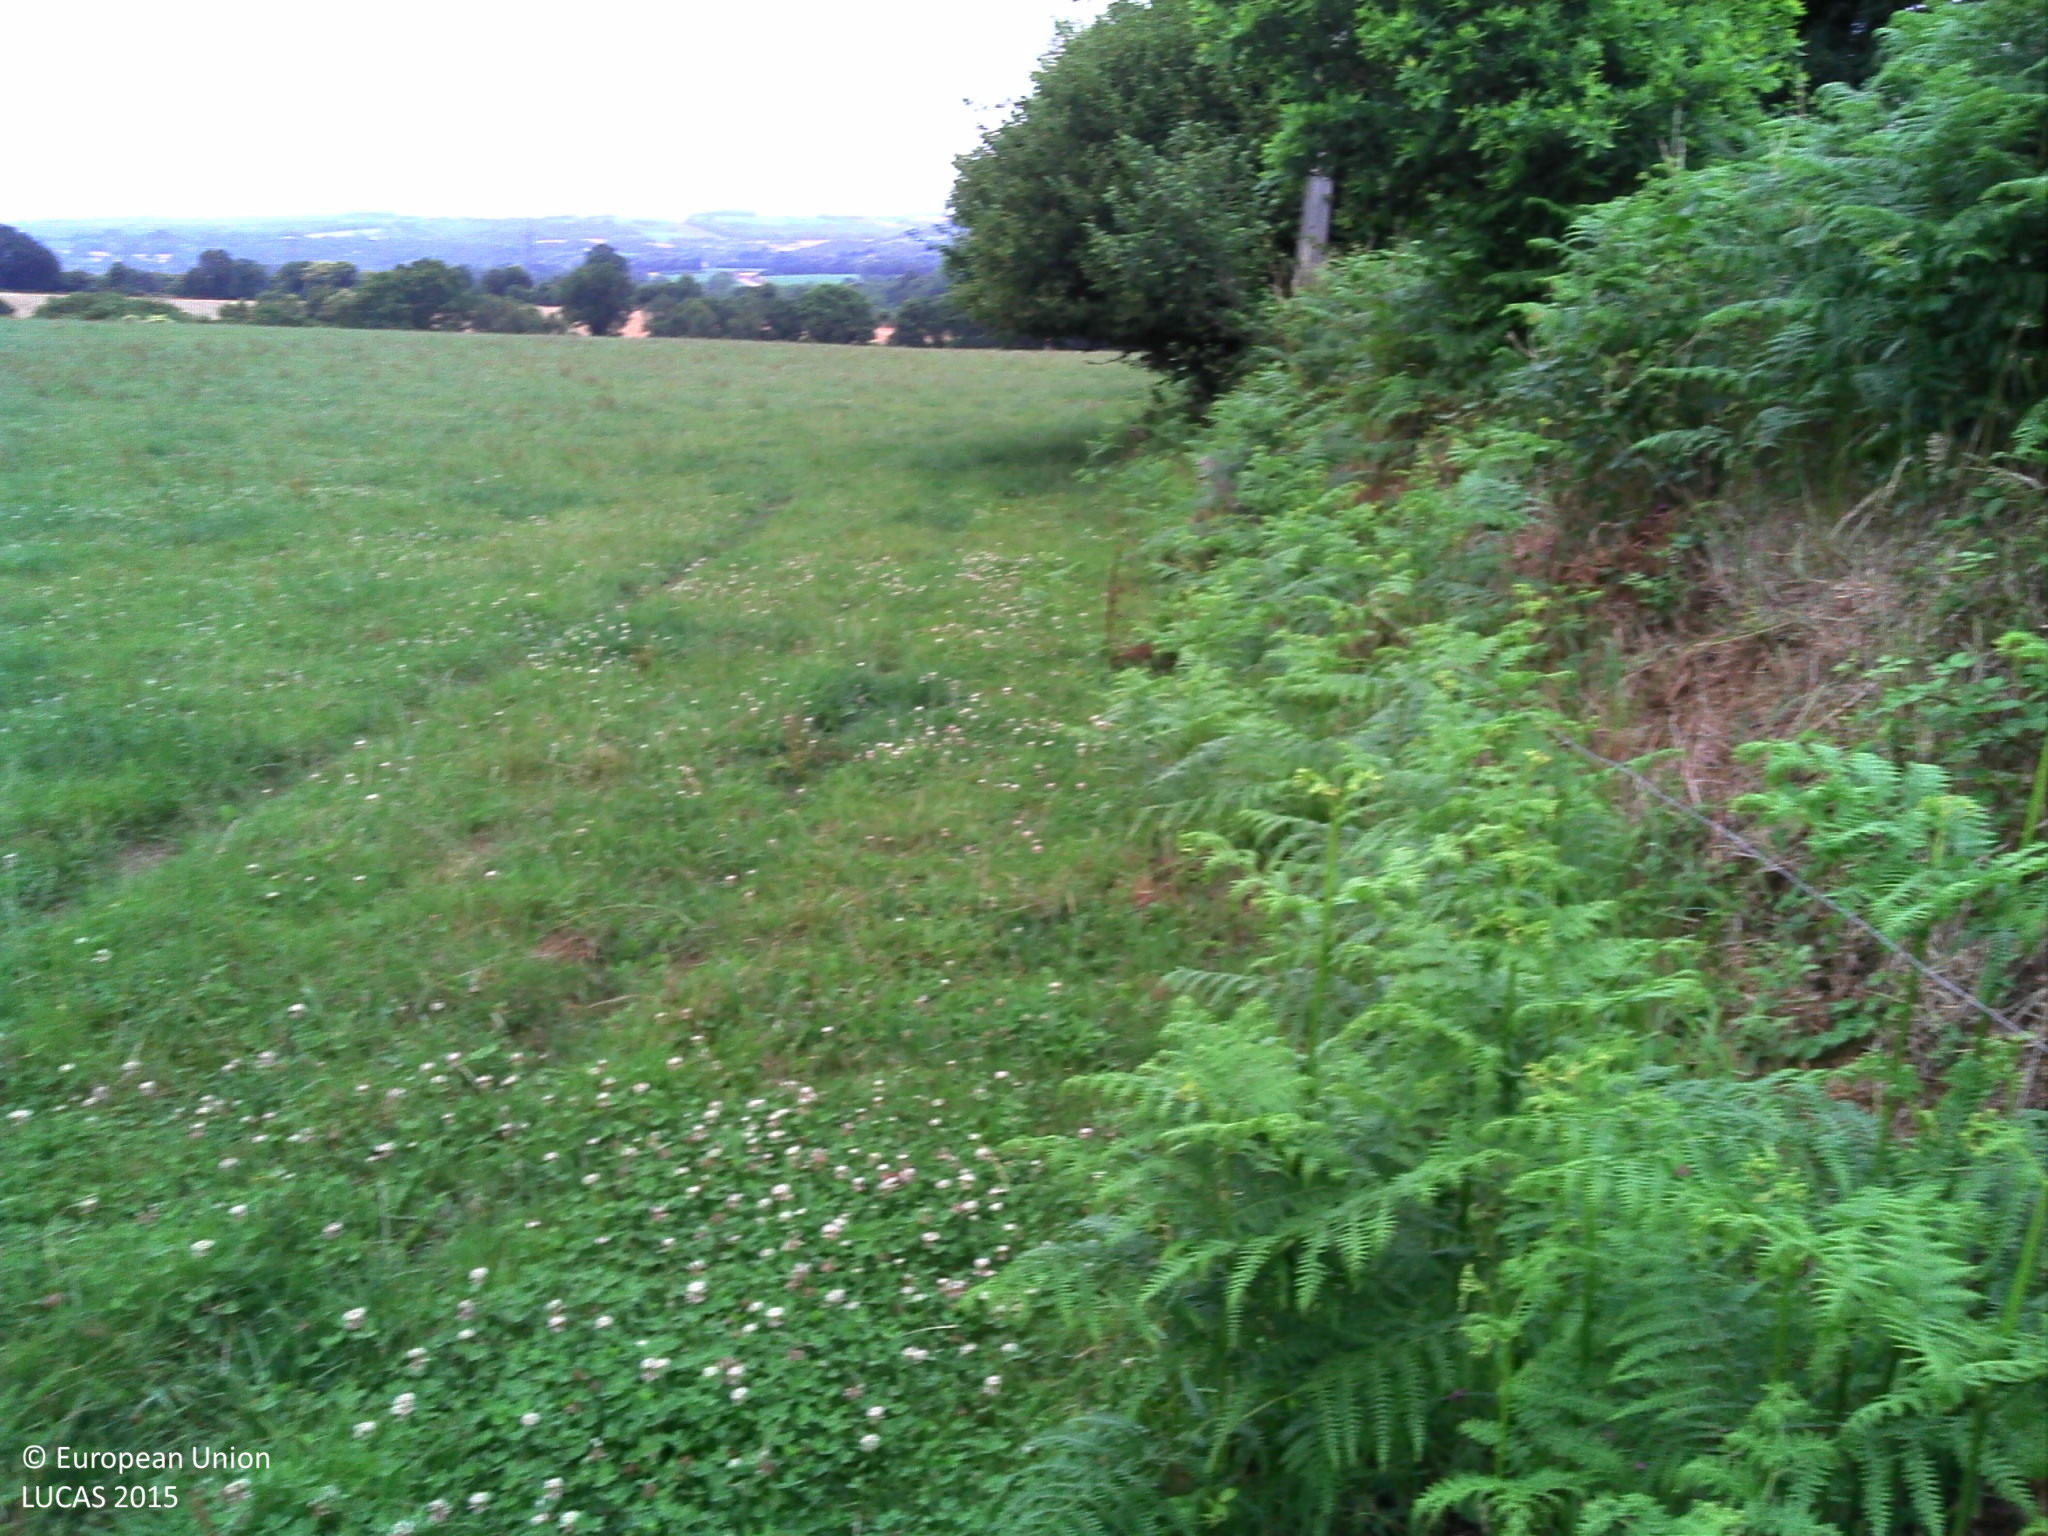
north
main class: Grassland
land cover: Grassland without tree/shrub cover
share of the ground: > 75 %
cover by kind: herbaceous plants 100 %
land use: Agriculture (excluding fallow land and kitchen gardens)
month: July
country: FR
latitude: 48.1196
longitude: -3.6343
